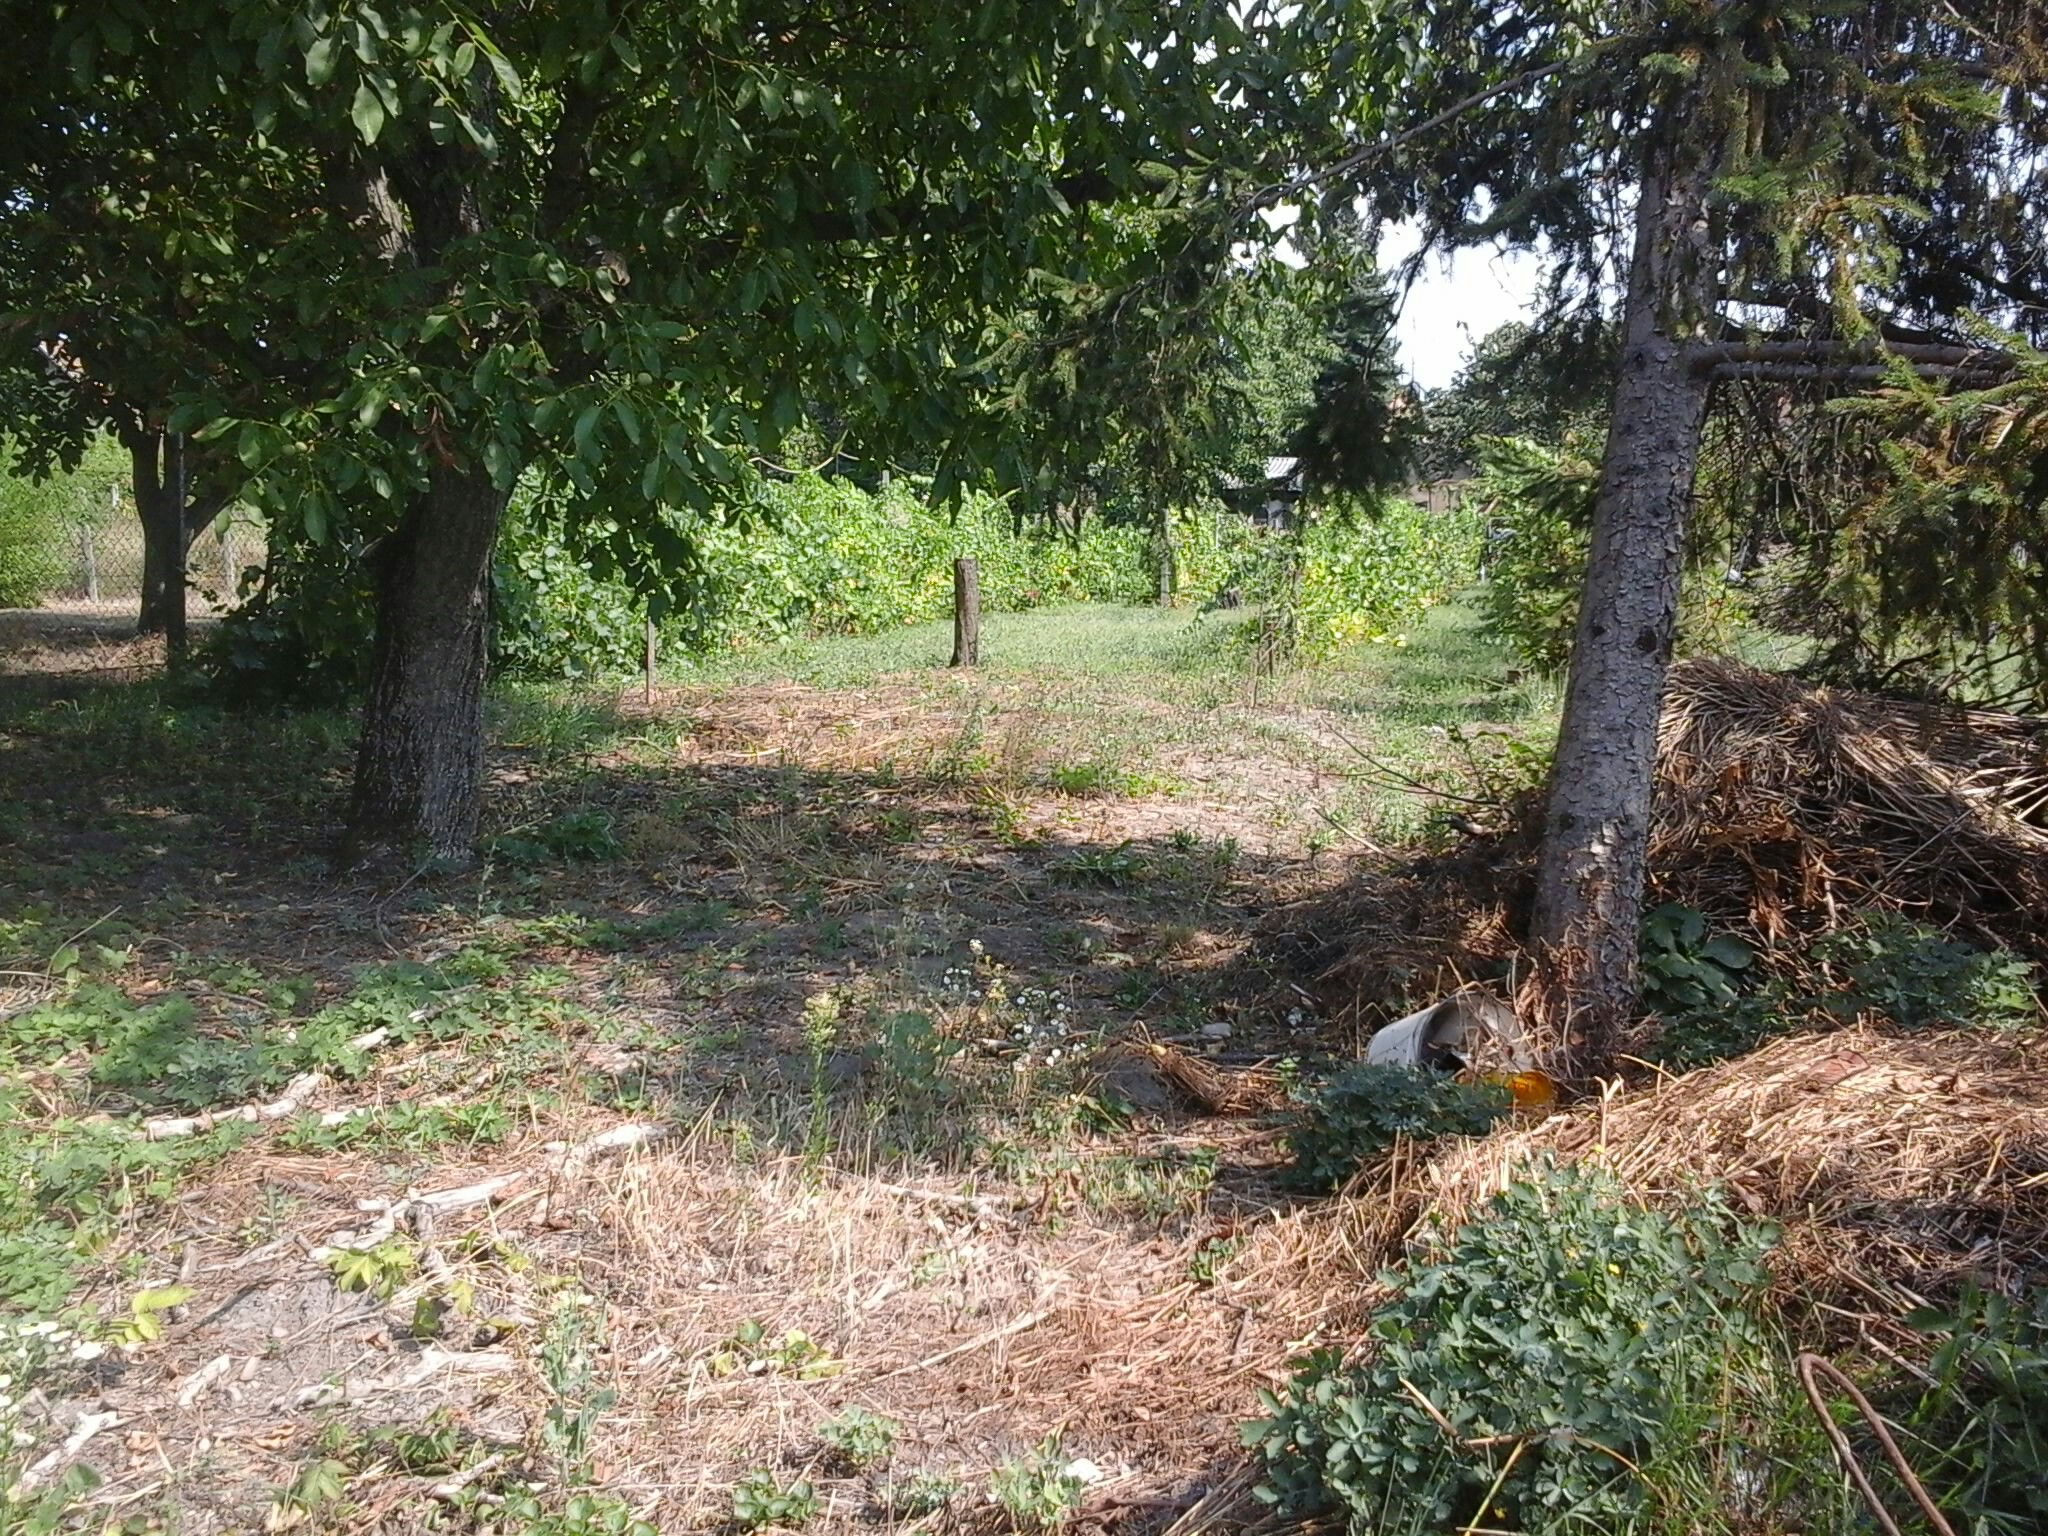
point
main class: Cropland
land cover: Vineyards
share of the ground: 10 - 25 %
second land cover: Grassland without tree/shrub cover
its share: 50 - 75 %
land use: Kitchen garden
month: August
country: HU
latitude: 48.0834
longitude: 19.2980
